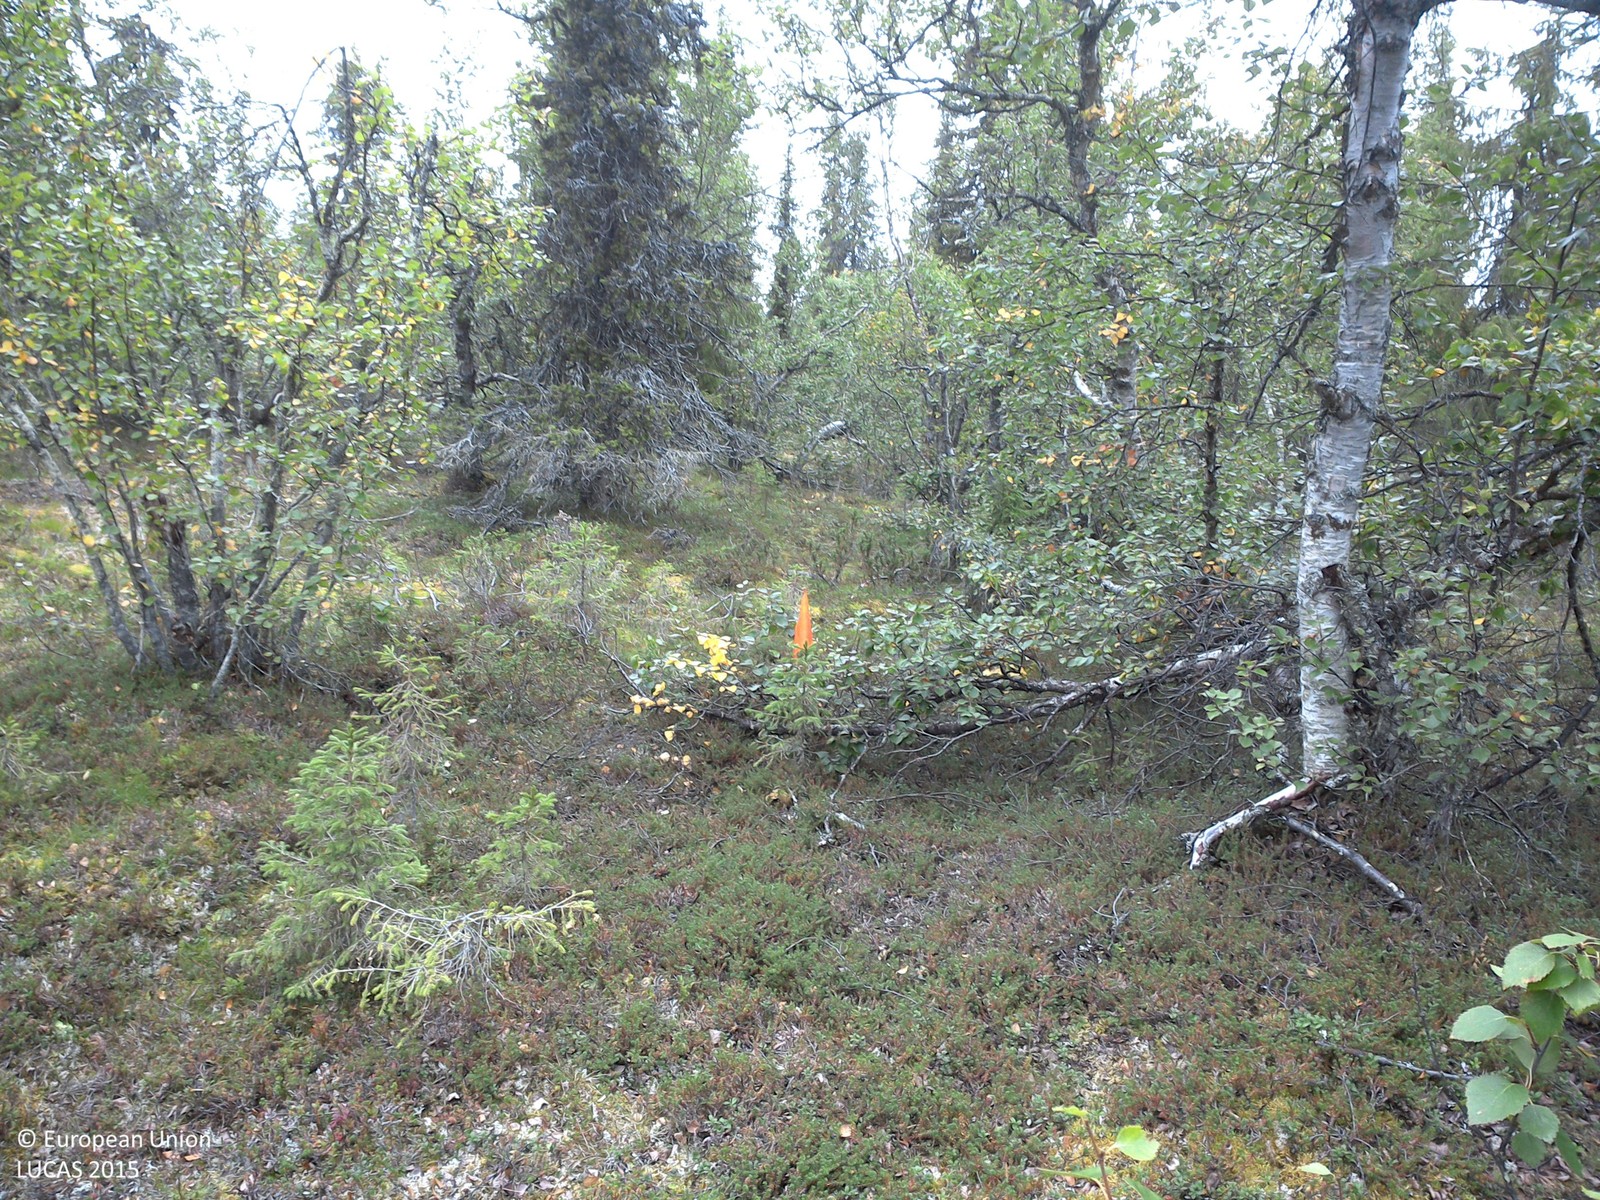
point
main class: Woodland
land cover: Spruce dominated mixed woodland
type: boreal forest
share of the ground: 25 - 50 %
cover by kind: shrubs 50 %, coniferous forest trees 20 %, broadleaved forest trees 15 %, lichens and mosses 15 %
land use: Amenities, museums, leisure
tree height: > 5 m
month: August
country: SE
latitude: 67.9966
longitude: 22.2659
